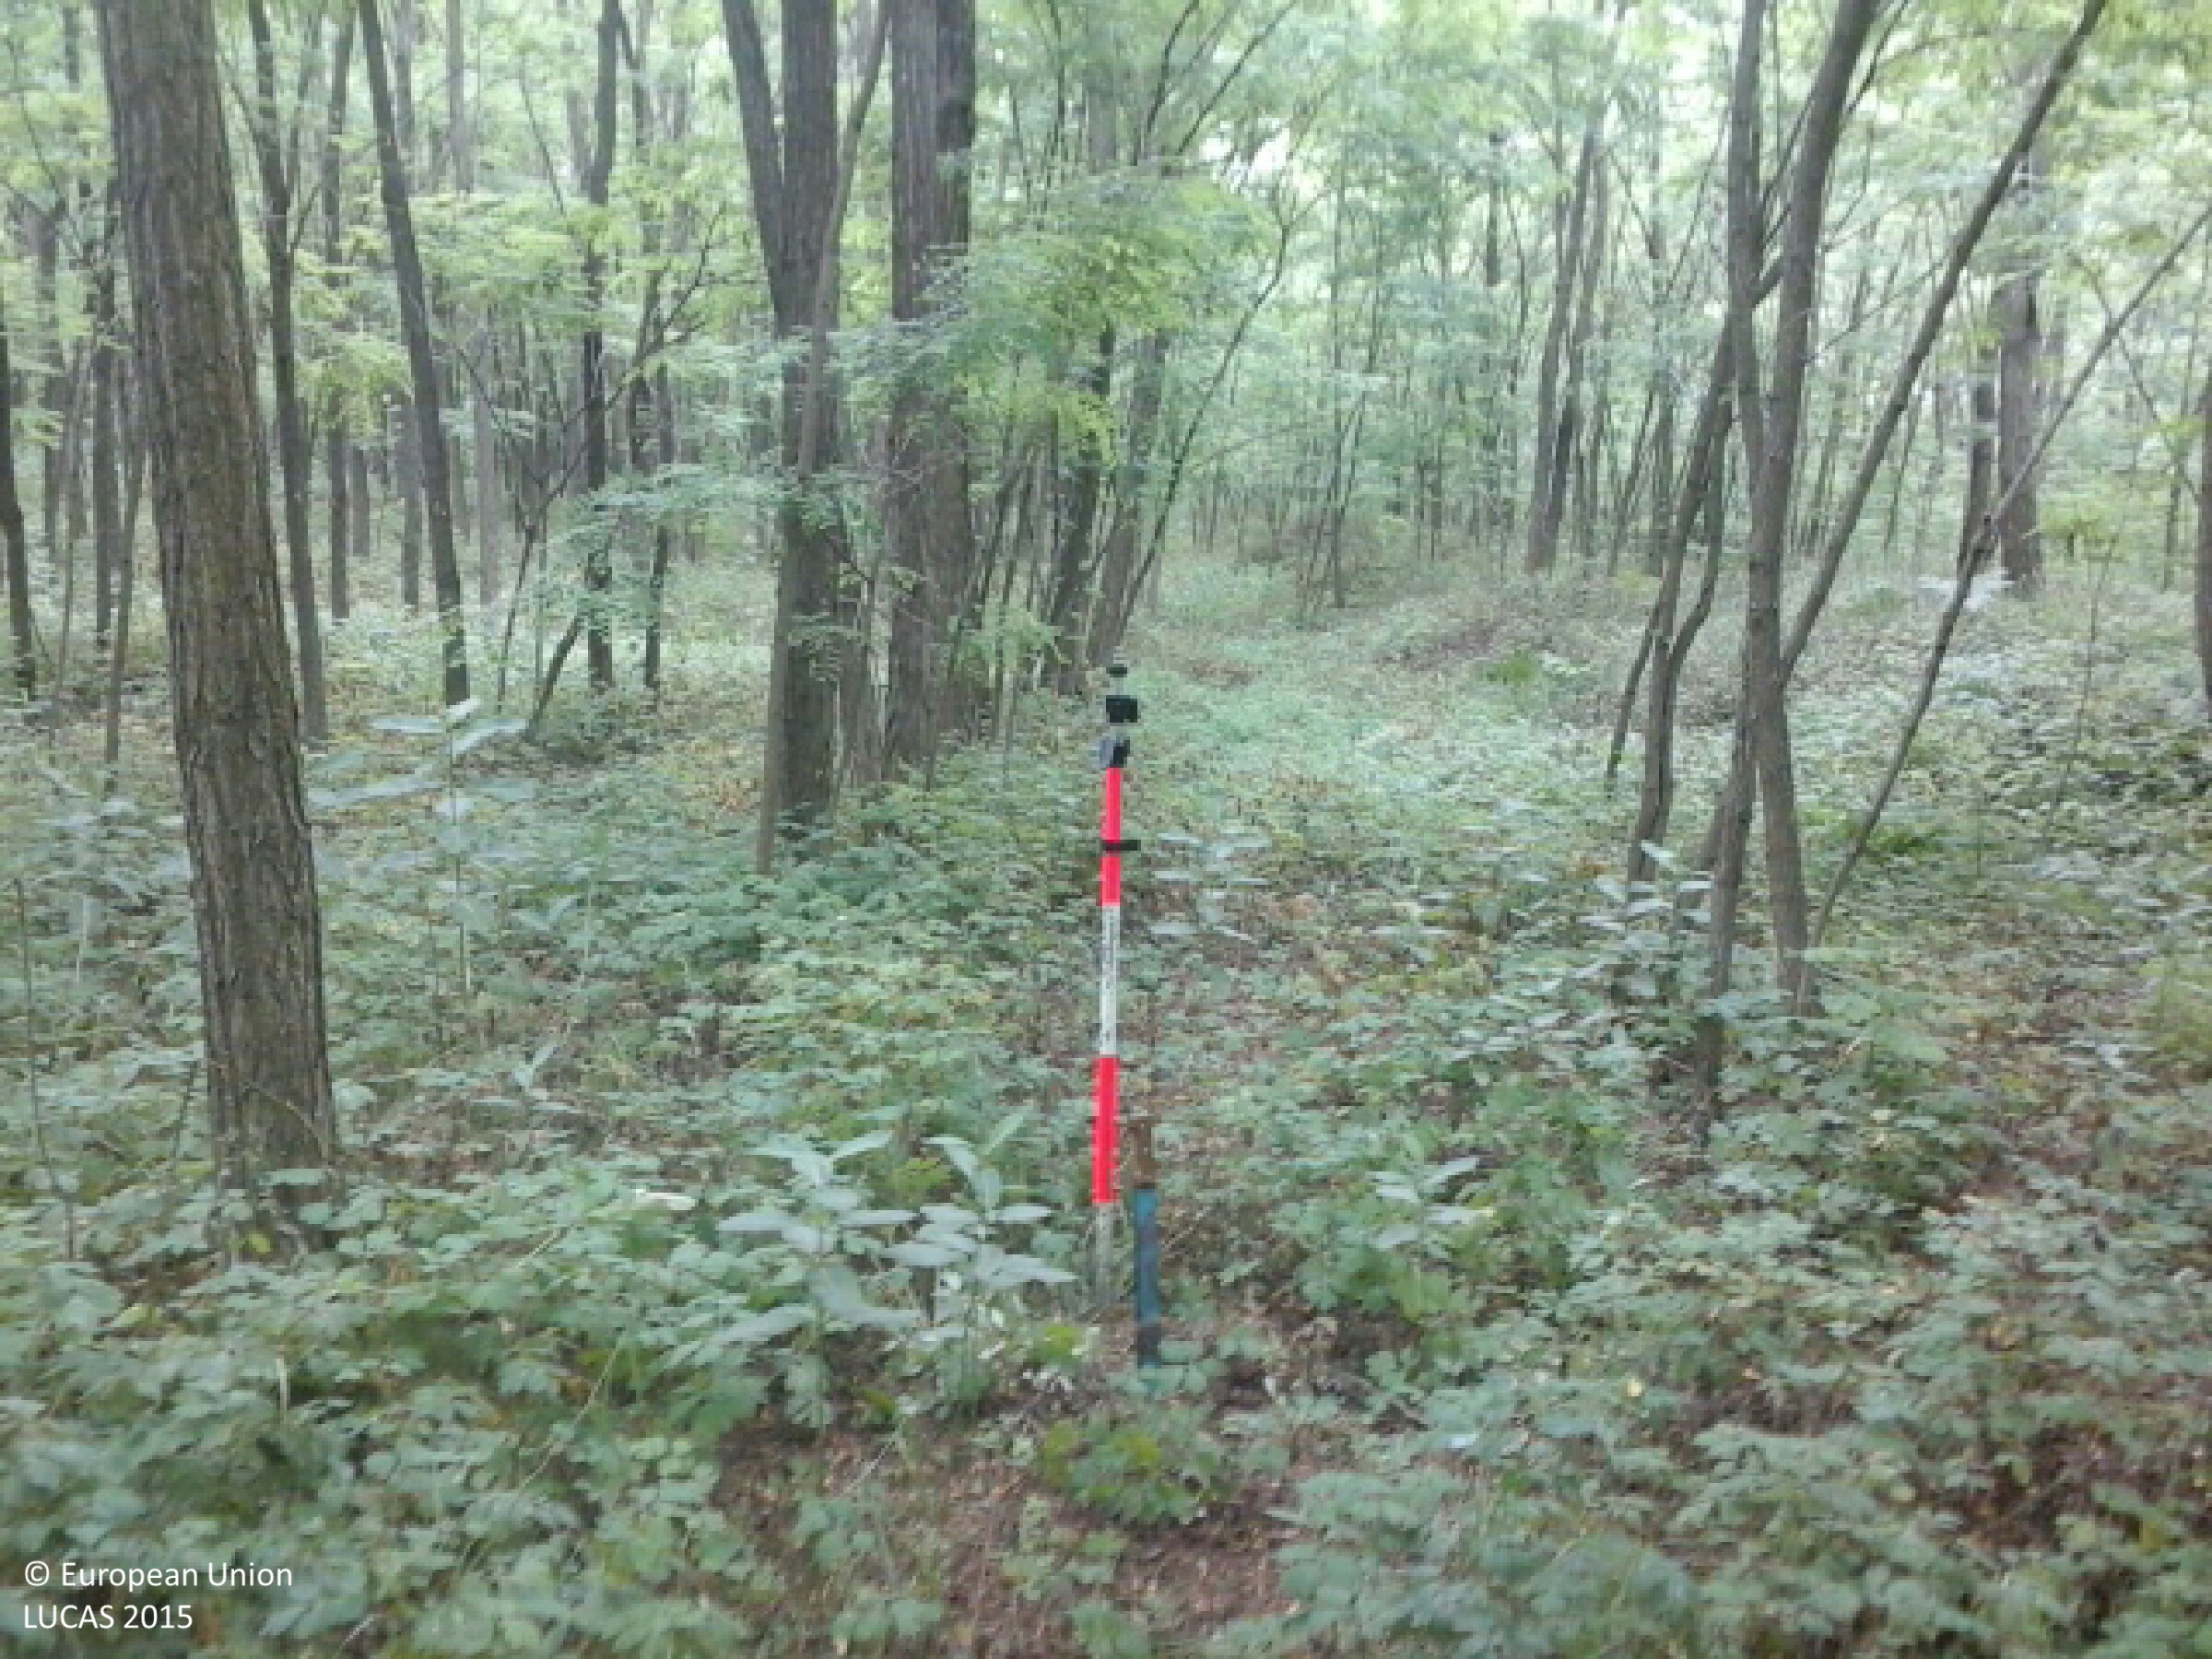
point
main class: Woodland
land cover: Broadleaved woodland
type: exotic forest
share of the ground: > 75 %
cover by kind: broadleaved forest trees 80 %, herbaceous plants 15 %, shrubs 5 %
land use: Forestry
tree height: > 5 m
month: June
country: HU
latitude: 48.1060
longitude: 22.2098
